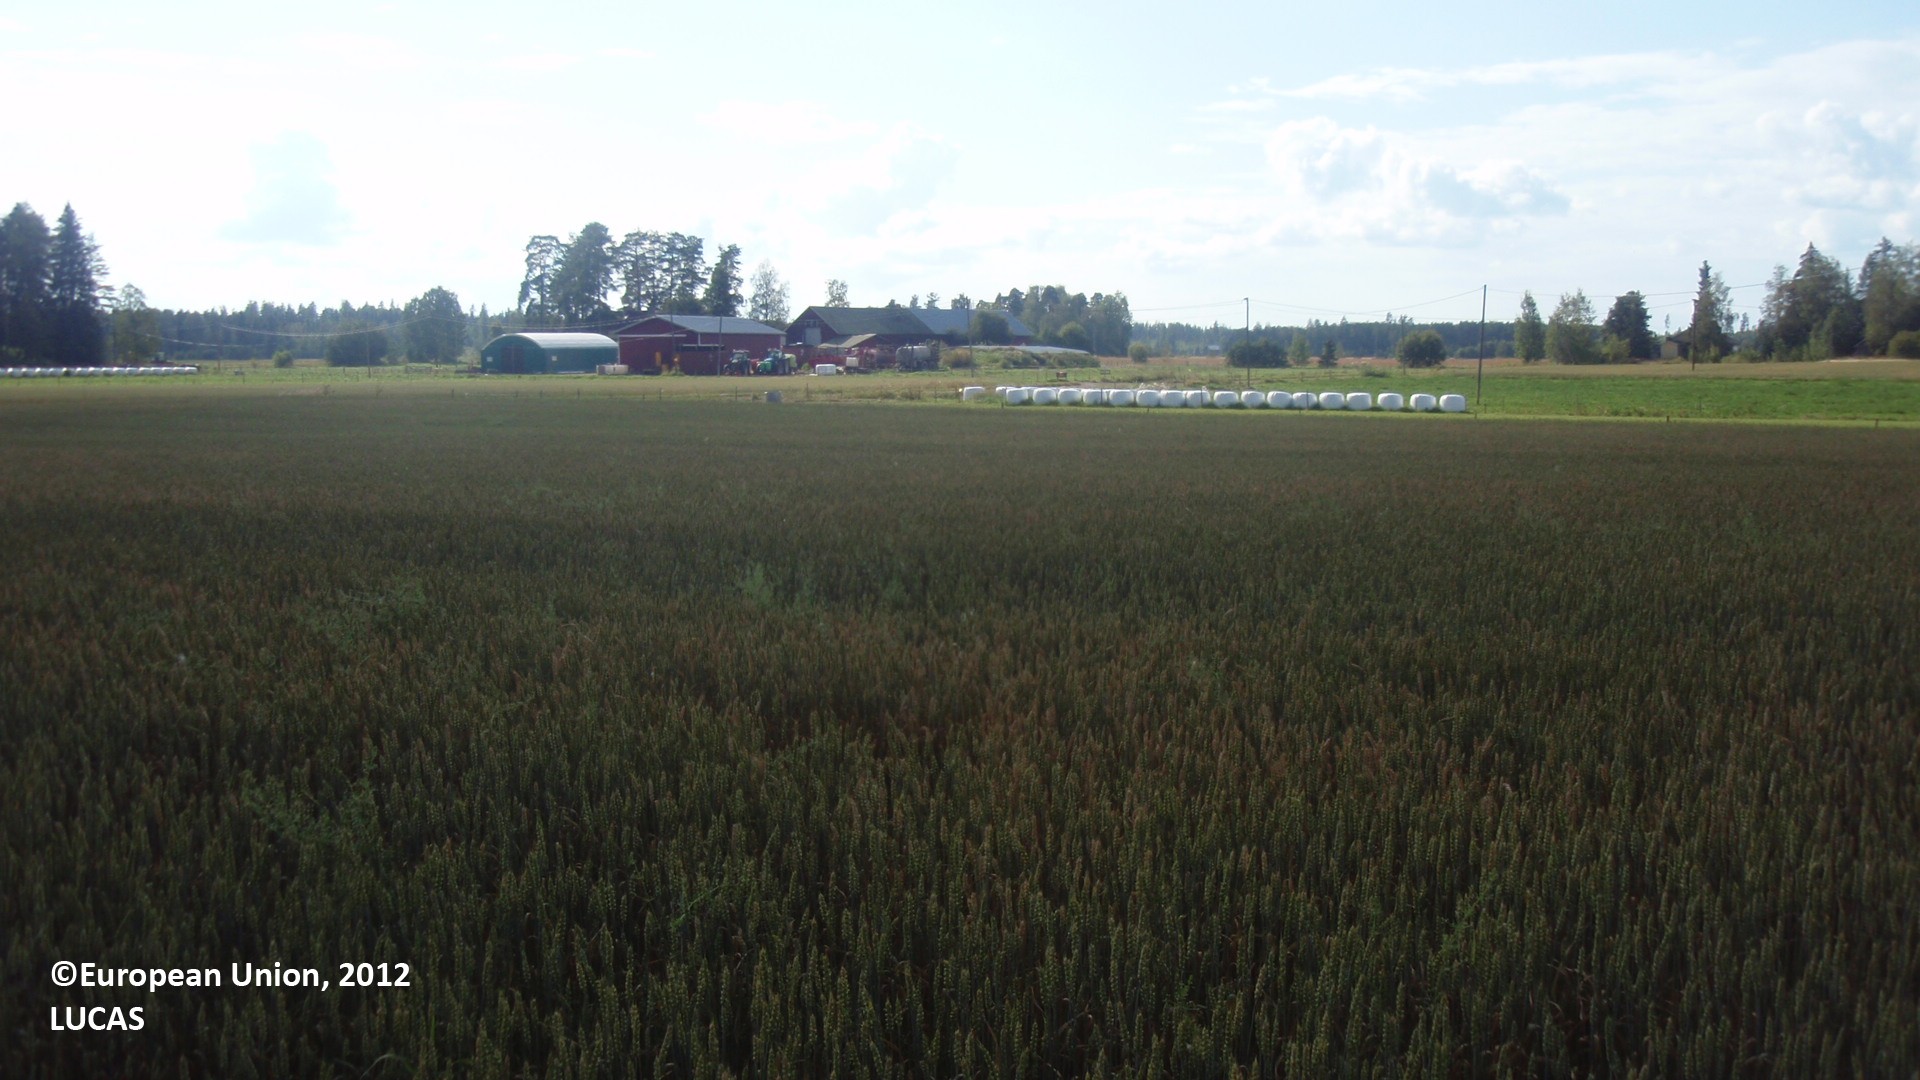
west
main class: Cropland
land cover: Rye
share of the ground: > 75 %
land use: Agriculture (excluding fallow land and kitchen gardens)
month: August
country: FI
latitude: 61.0110
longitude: 26.7891
